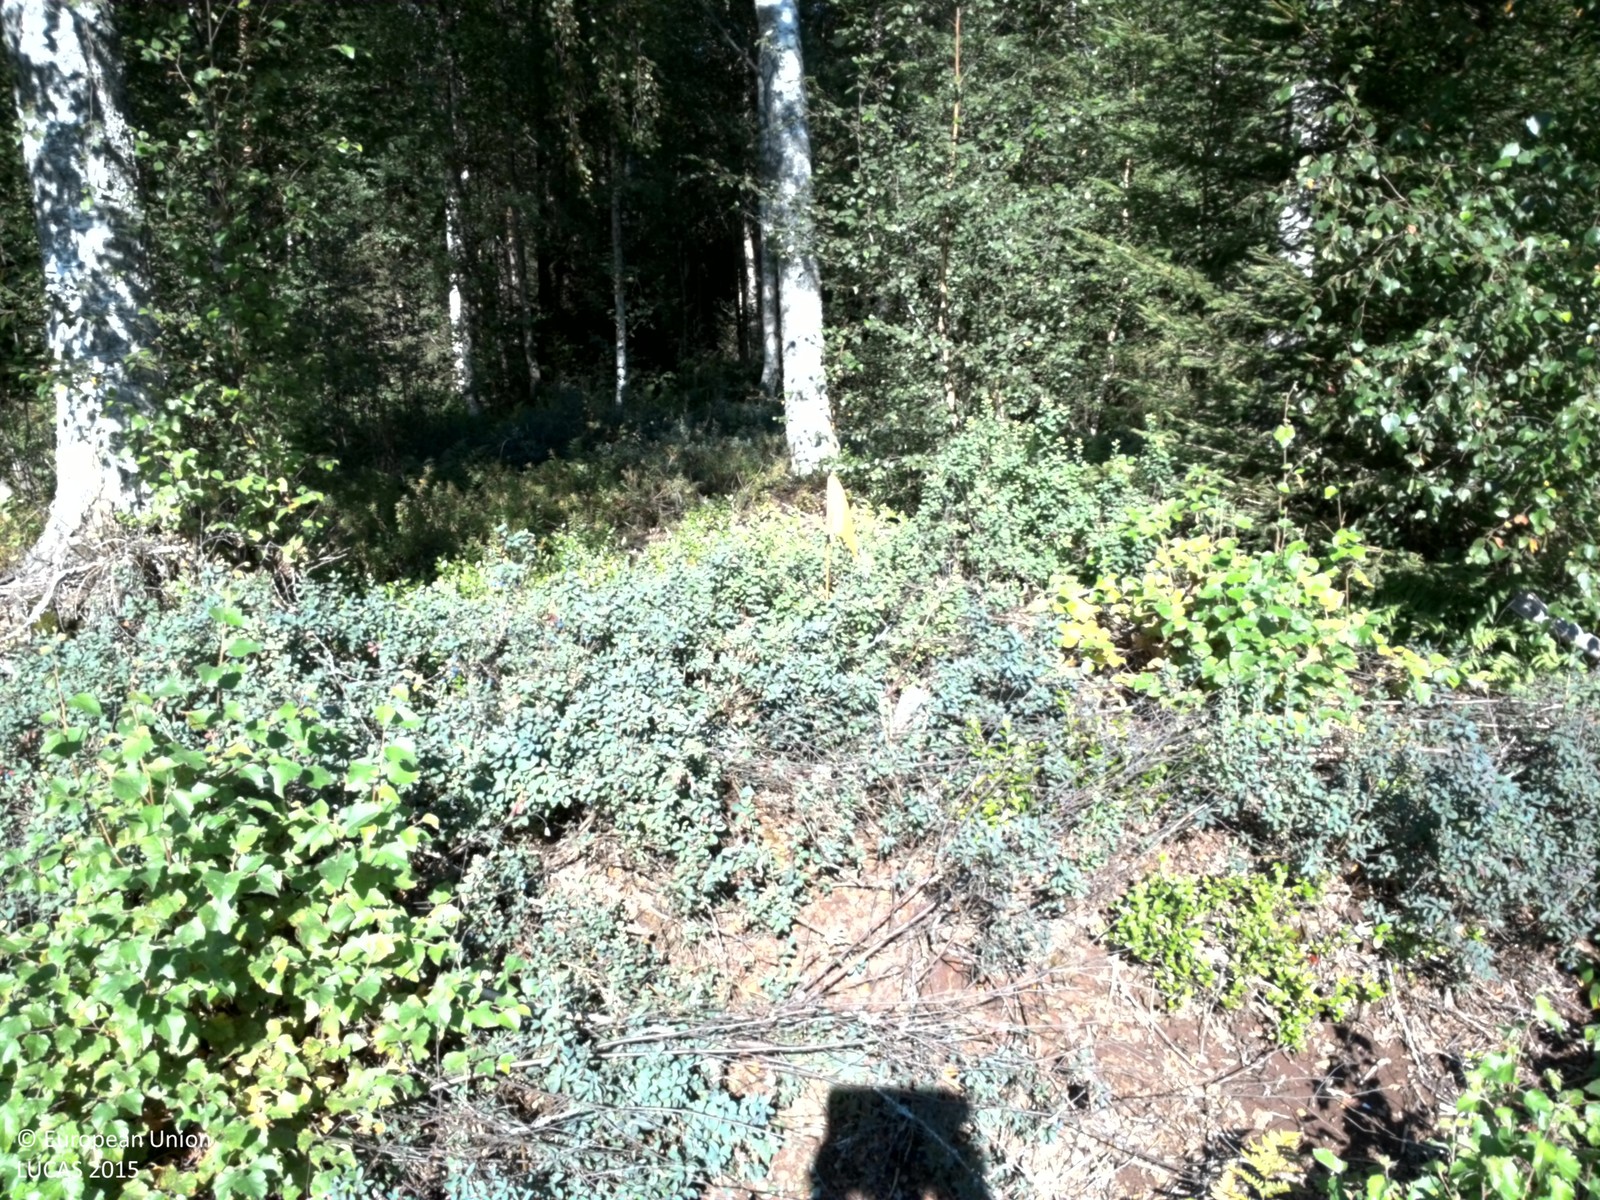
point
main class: Woodland
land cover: Broadleaved woodland
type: hemiboreal forest and nemoral coniferous forest and mixed broadleaved-coniferous forest
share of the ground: > 75 %
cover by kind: broadleaved forest trees 80 %, shrubs 15 %, coniferous forest trees 5 %
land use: Forestry
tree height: > 5 m
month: August
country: SE
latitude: 60.0621
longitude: 16.9793
